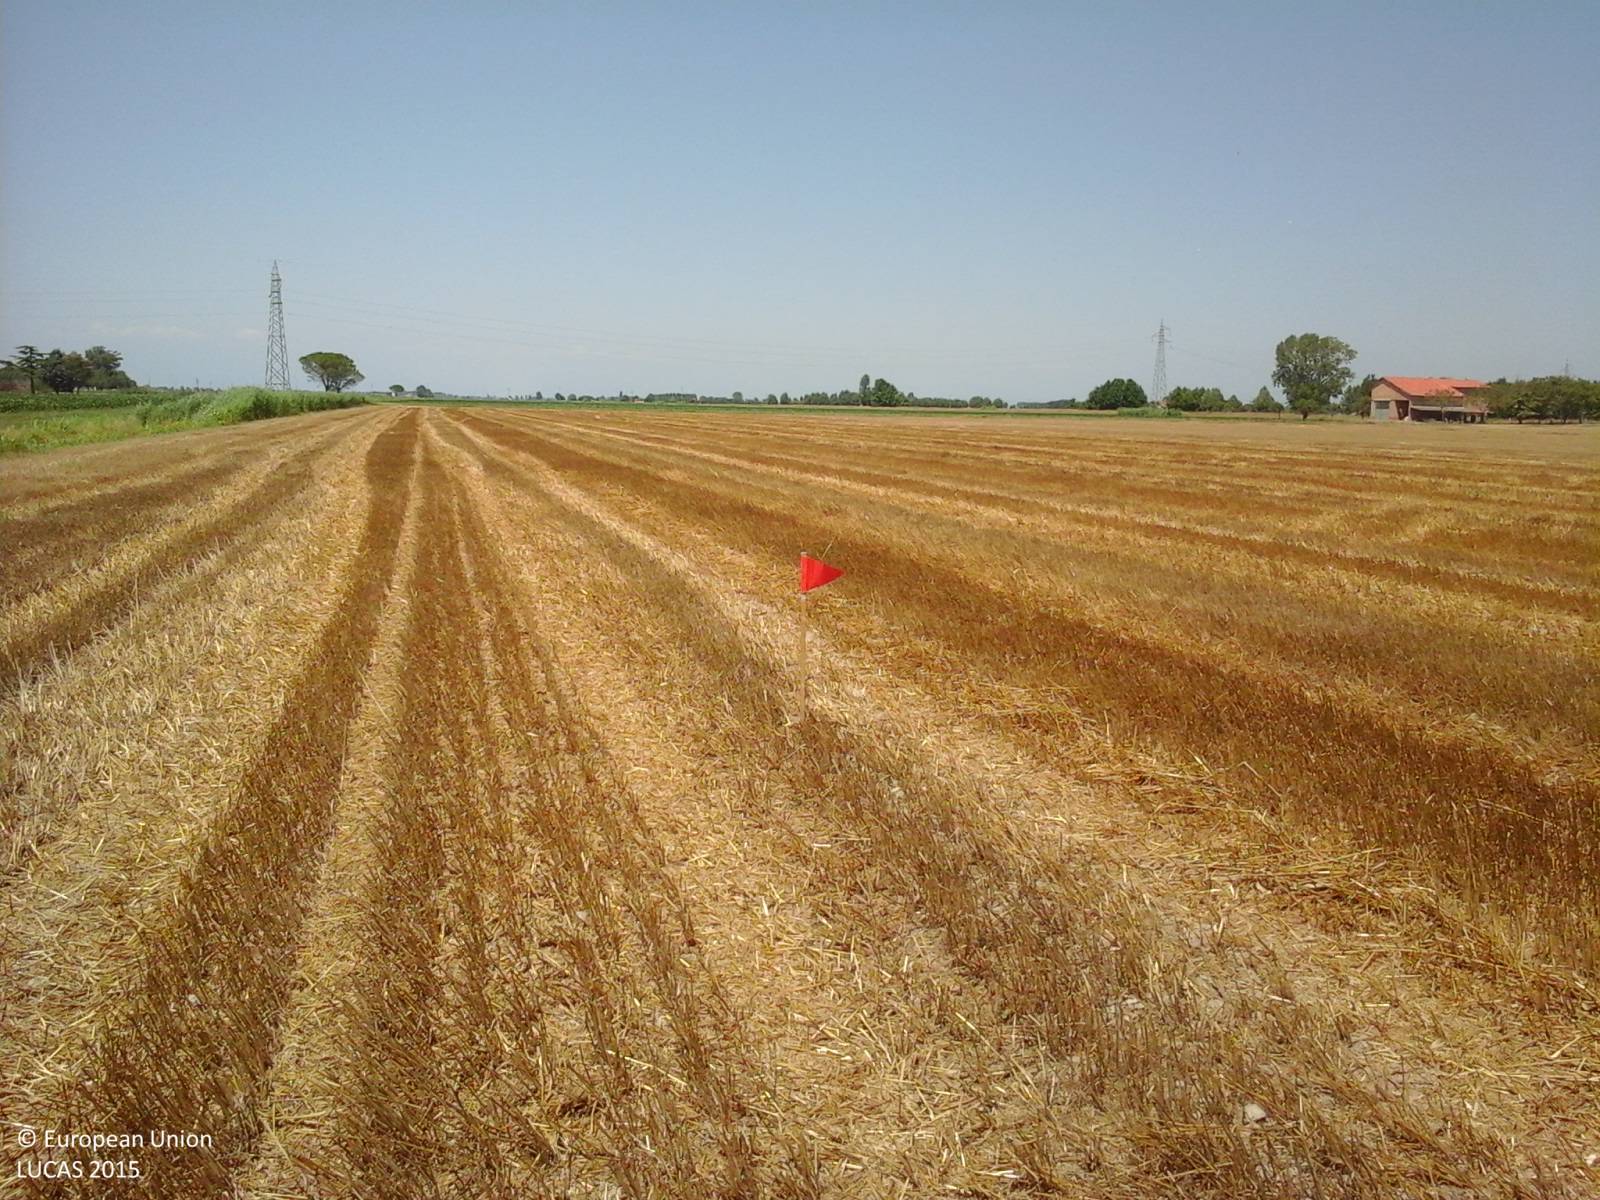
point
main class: Cropland
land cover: Common wheat
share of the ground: < 10 %
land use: Agriculture (excluding fallow land and kitchen gardens)
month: July
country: IT
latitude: 45.7513
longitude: 12.9656
